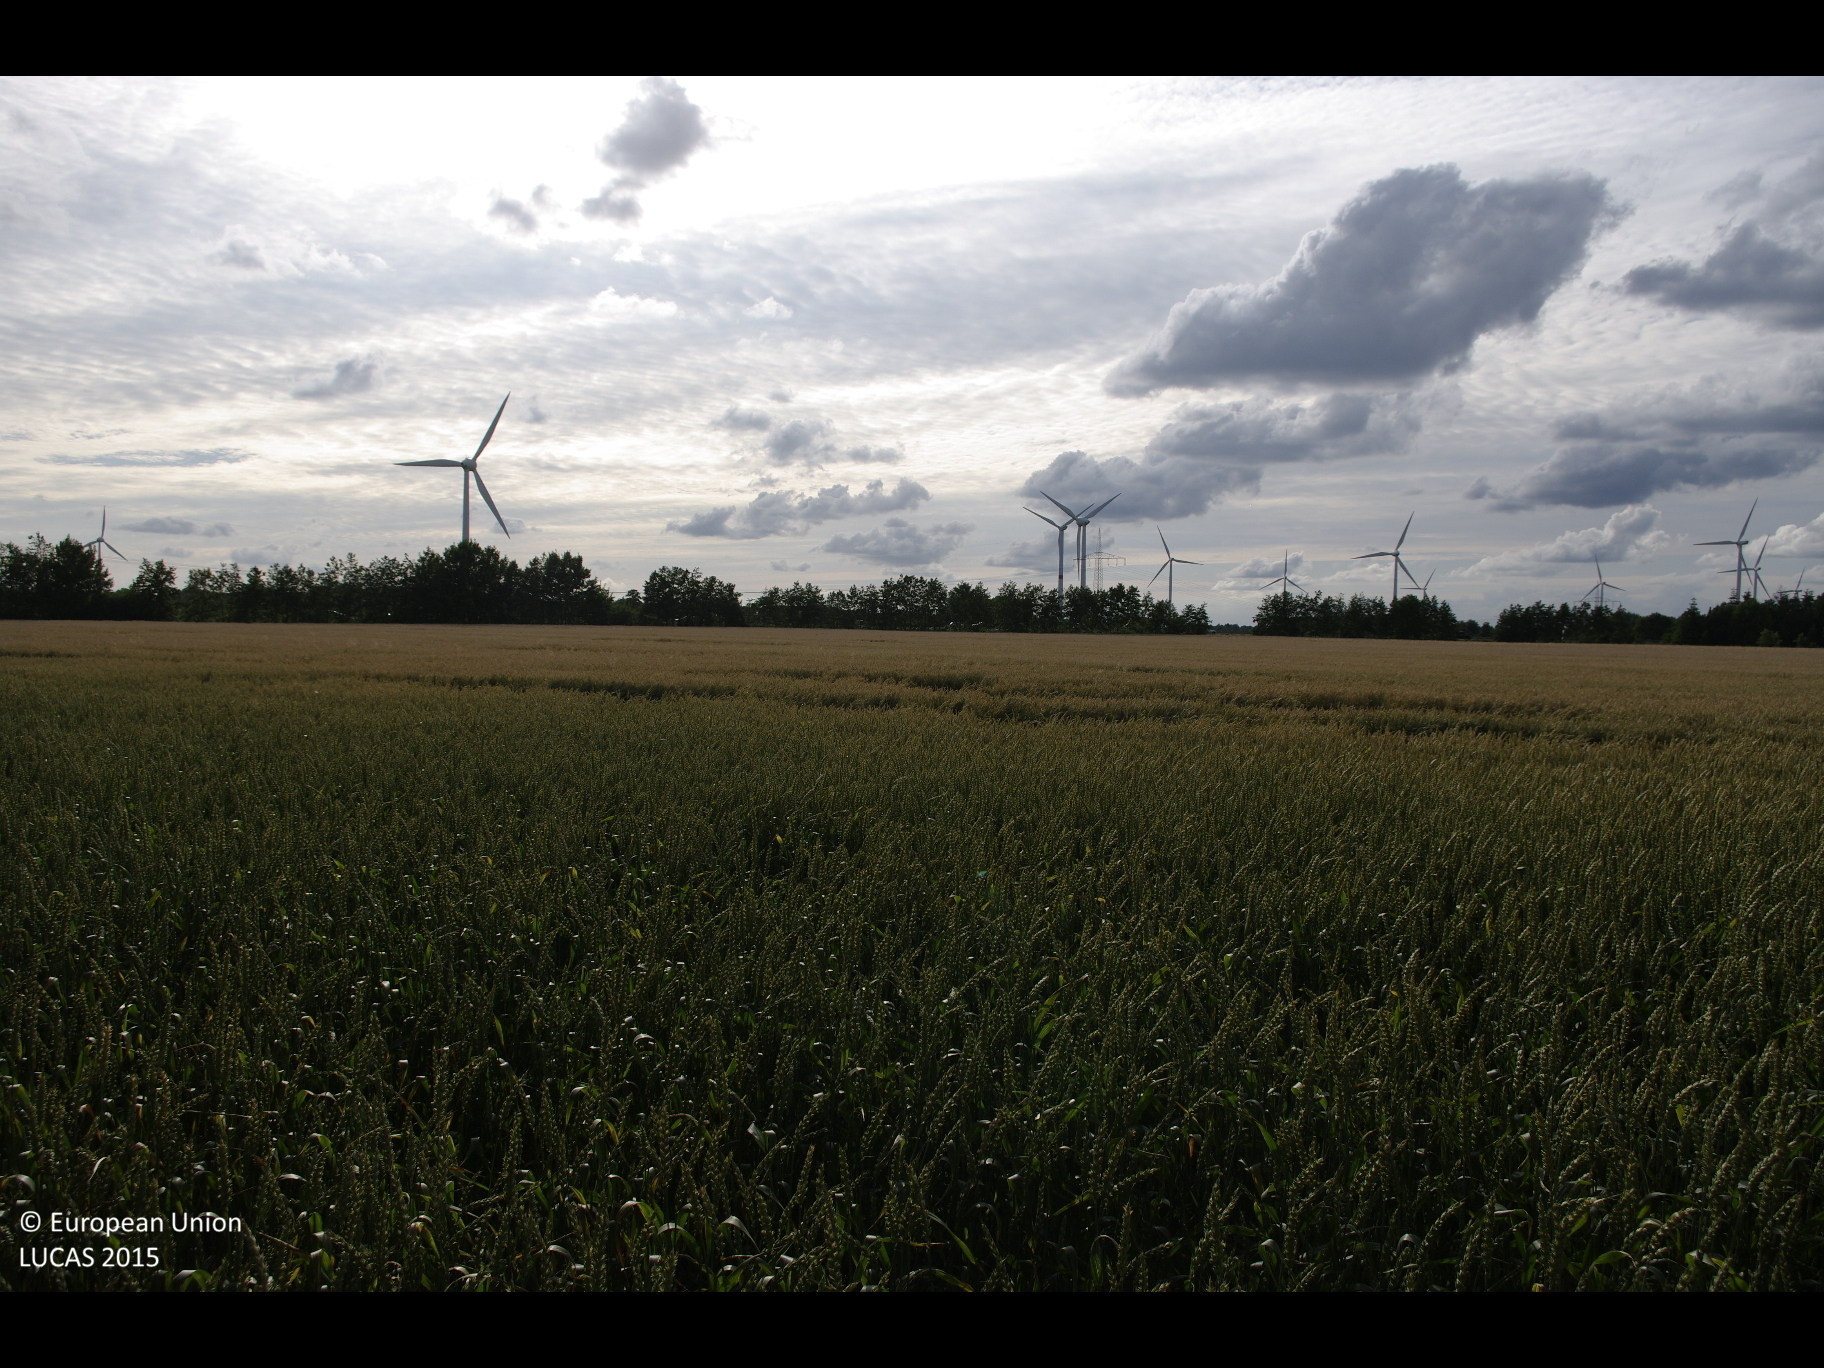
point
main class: Cropland
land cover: Common wheat
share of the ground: > 75 %
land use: Agriculture (excluding fallow land and kitchen gardens)
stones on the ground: < 10 %
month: July
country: DE
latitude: 53.9590
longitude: 9.9543
